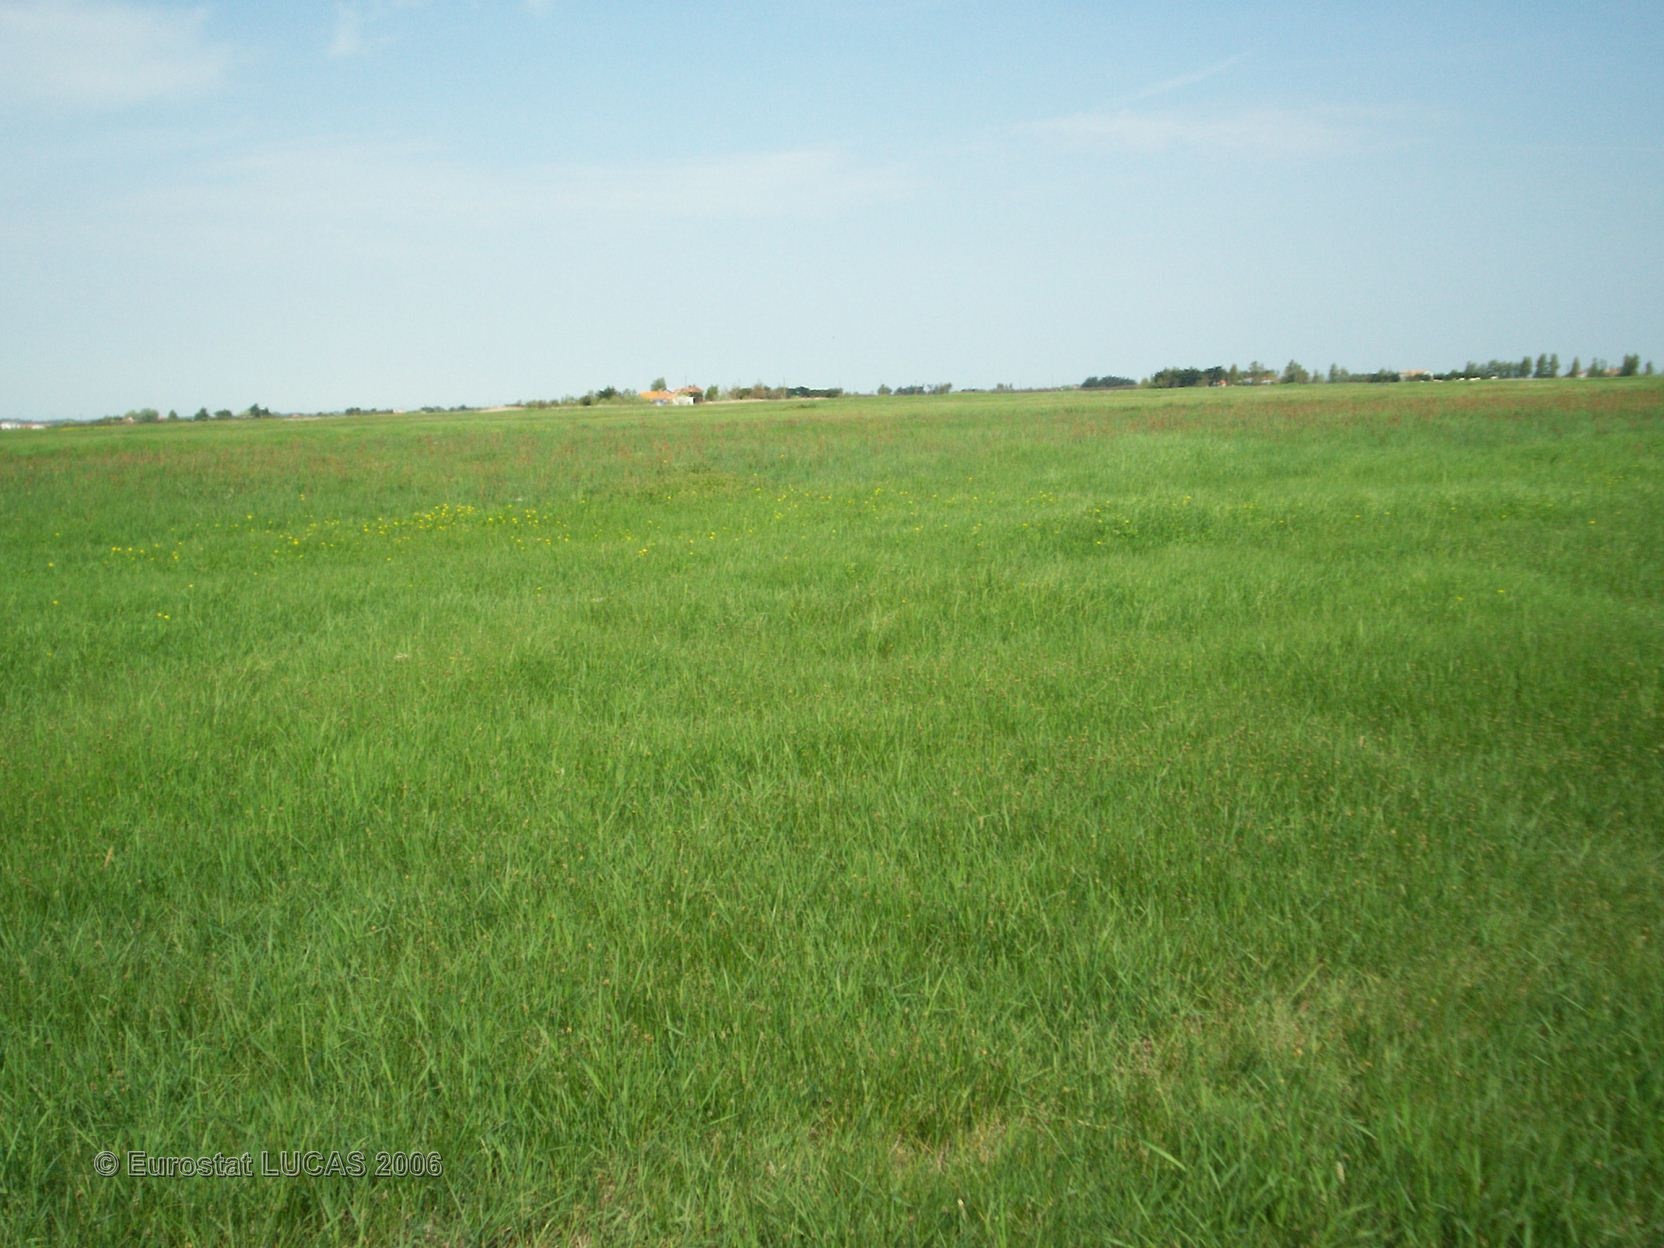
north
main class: Grassland
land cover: Grassland without tree/shrub cover
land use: Agriculture (excluding fallow land and kitchen gardens)
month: May
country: FR
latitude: 46.8476
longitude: -2.0727
